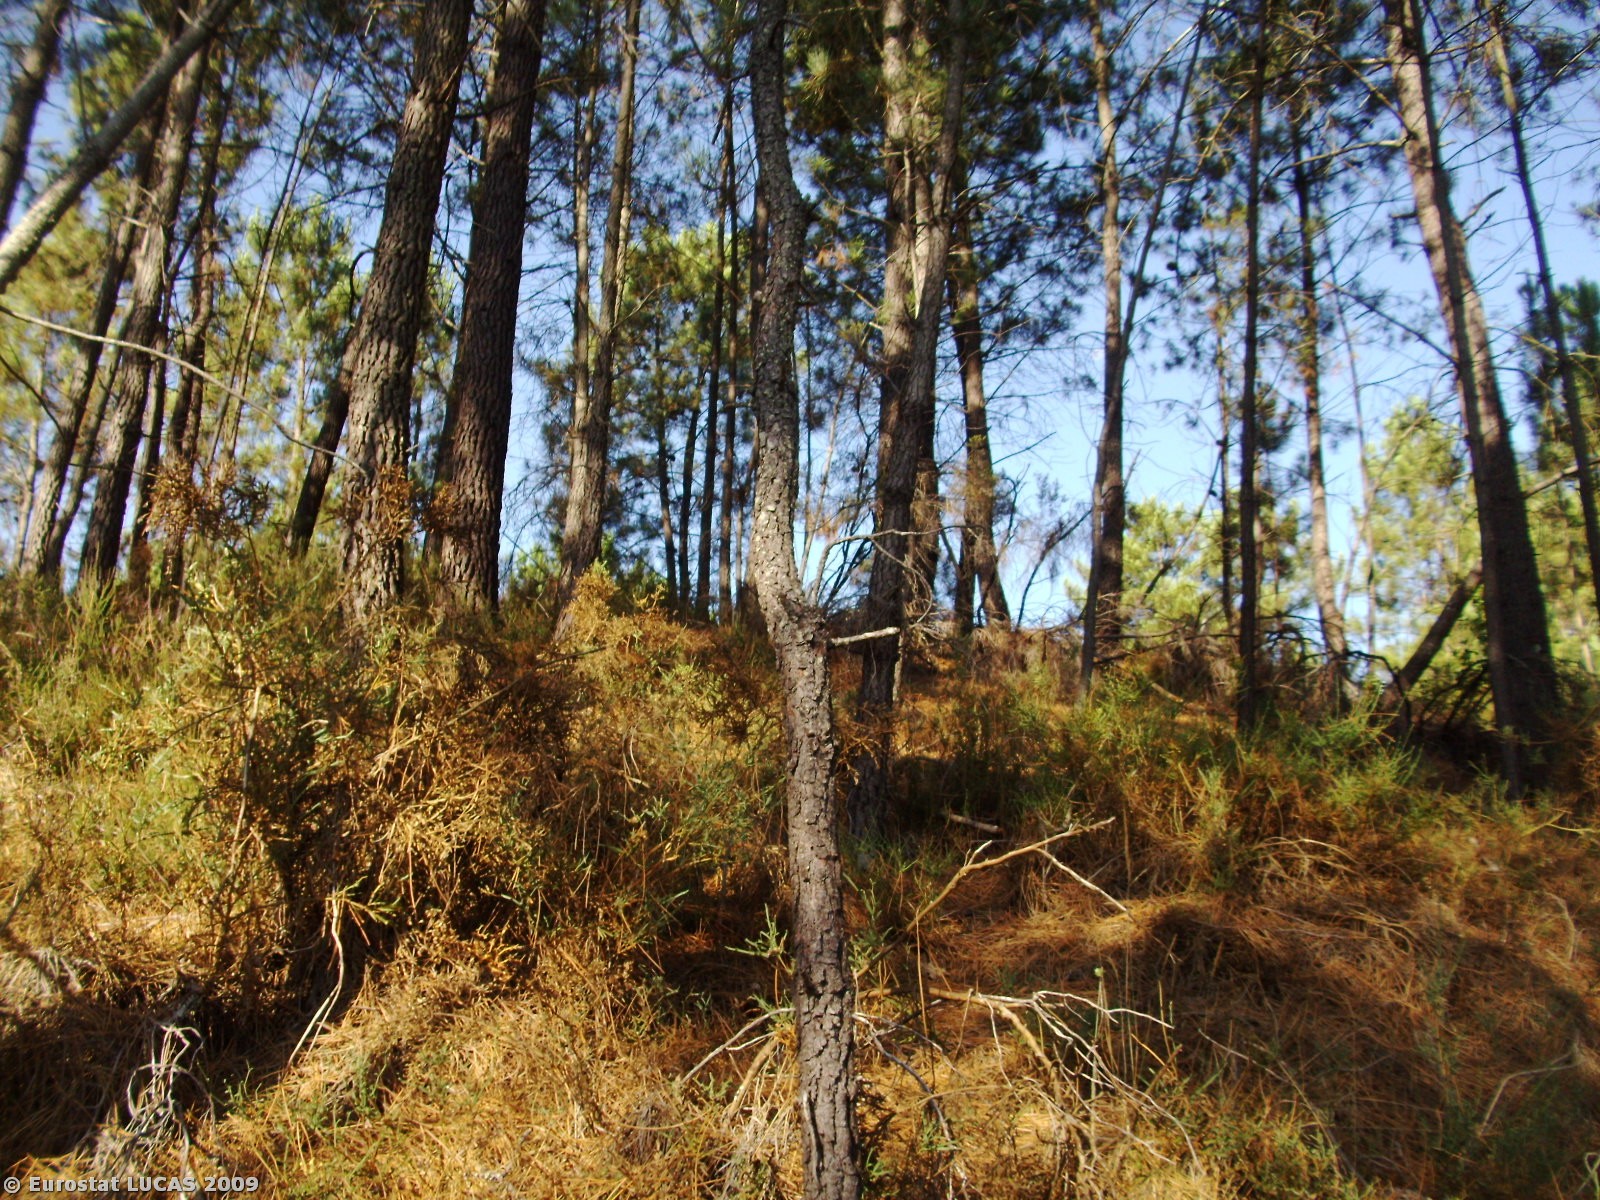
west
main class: Woodland
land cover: Coniferous woodland
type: coniferous forest of the mediterranean region
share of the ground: > 75 %
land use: Forestry
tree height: > 5 m
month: August
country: PT
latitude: 39.8039
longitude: -8.1132
